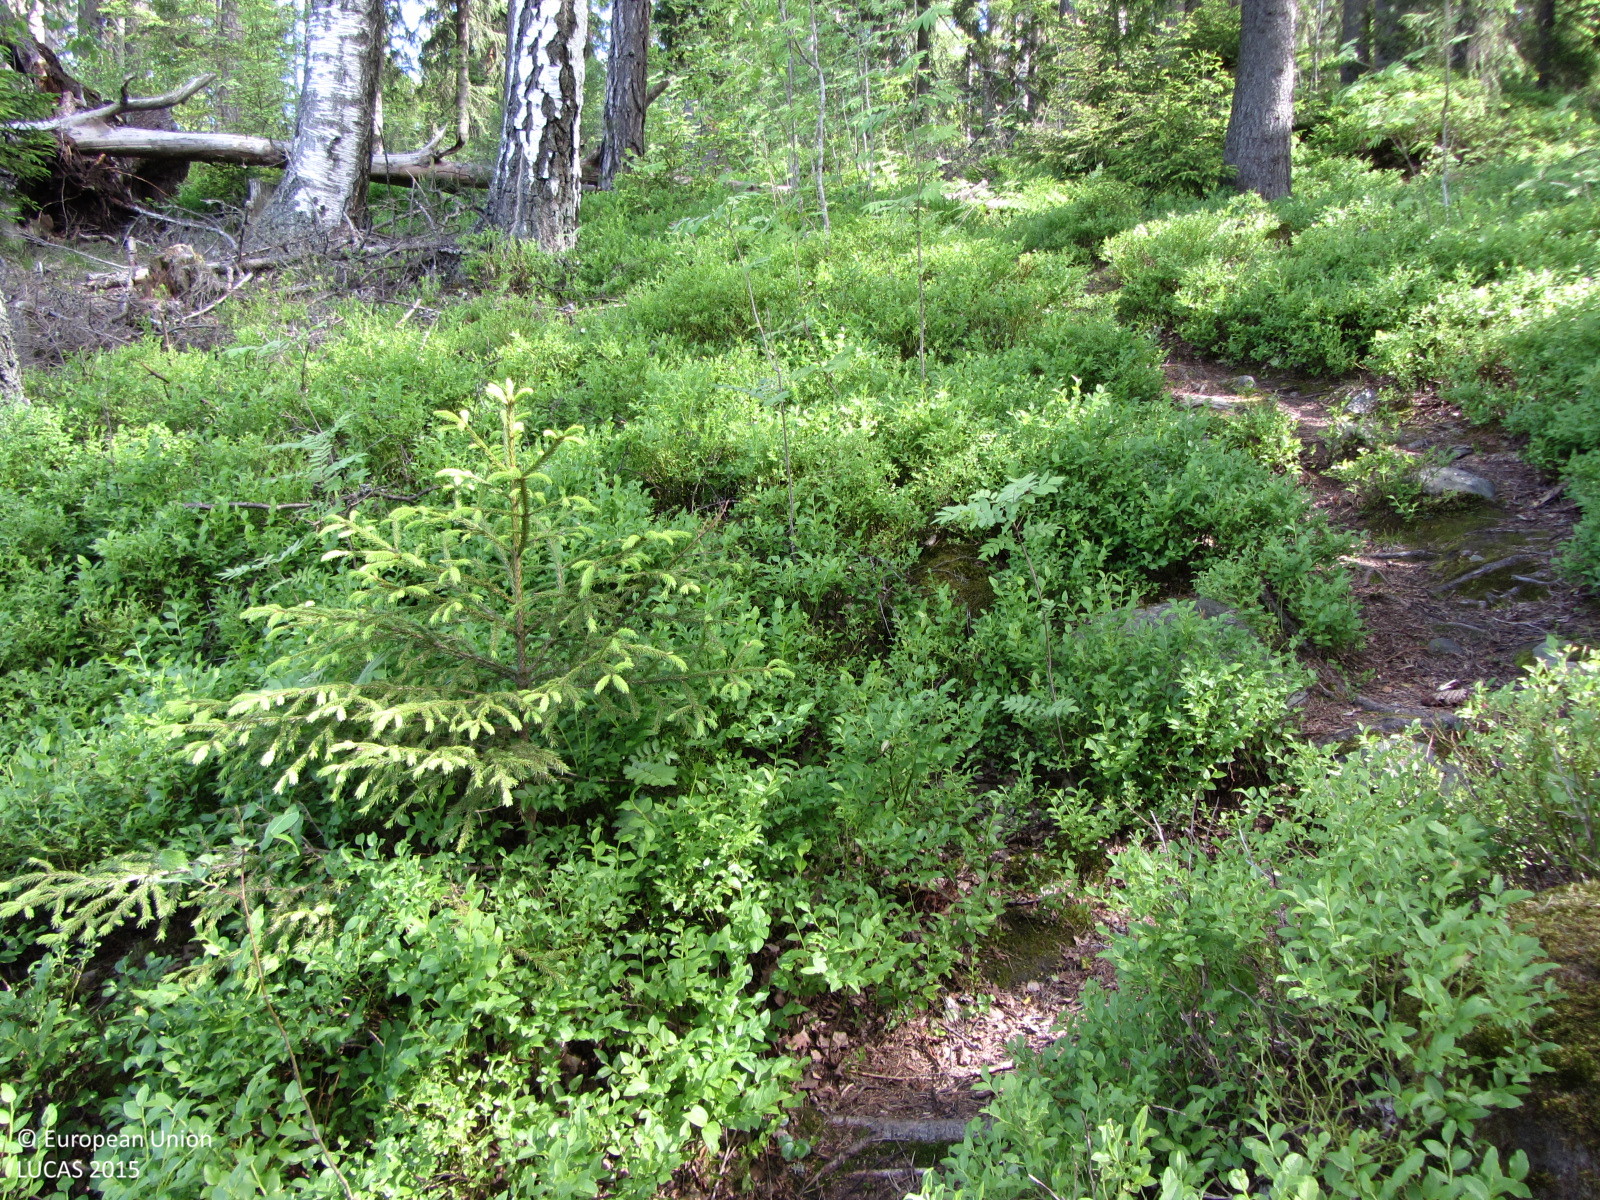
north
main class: Woodland
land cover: Spruce dominated mixed woodland
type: boreal forest
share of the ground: > 75 %
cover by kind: broadleaved forest trees 45 %, coniferous forest trees 40 %, shrubs 10 %, herbaceous plants 5 %
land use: Forestry
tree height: > 5 m
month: June
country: FI
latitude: 60.1707
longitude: 24.2148
